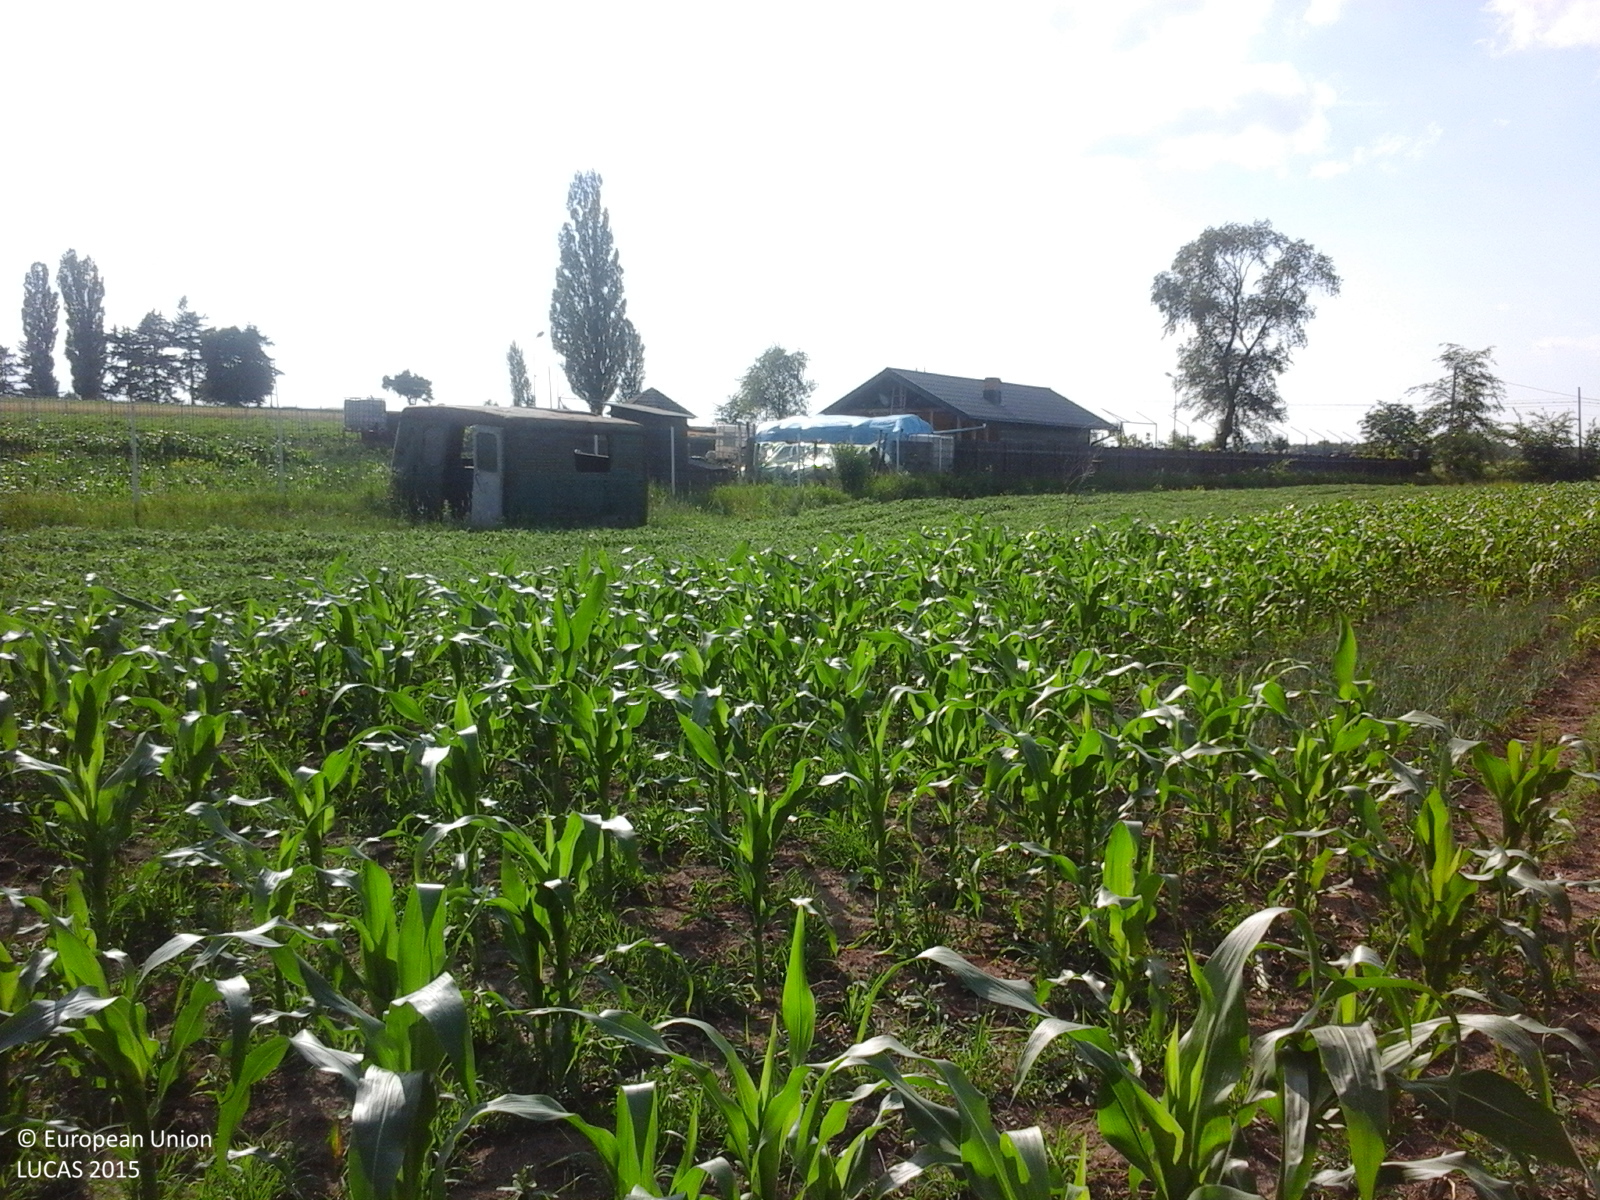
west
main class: Cropland
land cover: Other fruit trees and berries
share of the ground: > 75 %
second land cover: Grassland without tree/shrub cover
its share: > 75 %
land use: Agriculture (excluding fallow land and kitchen gardens)
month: June
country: RO
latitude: 47.9632
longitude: 26.3606
